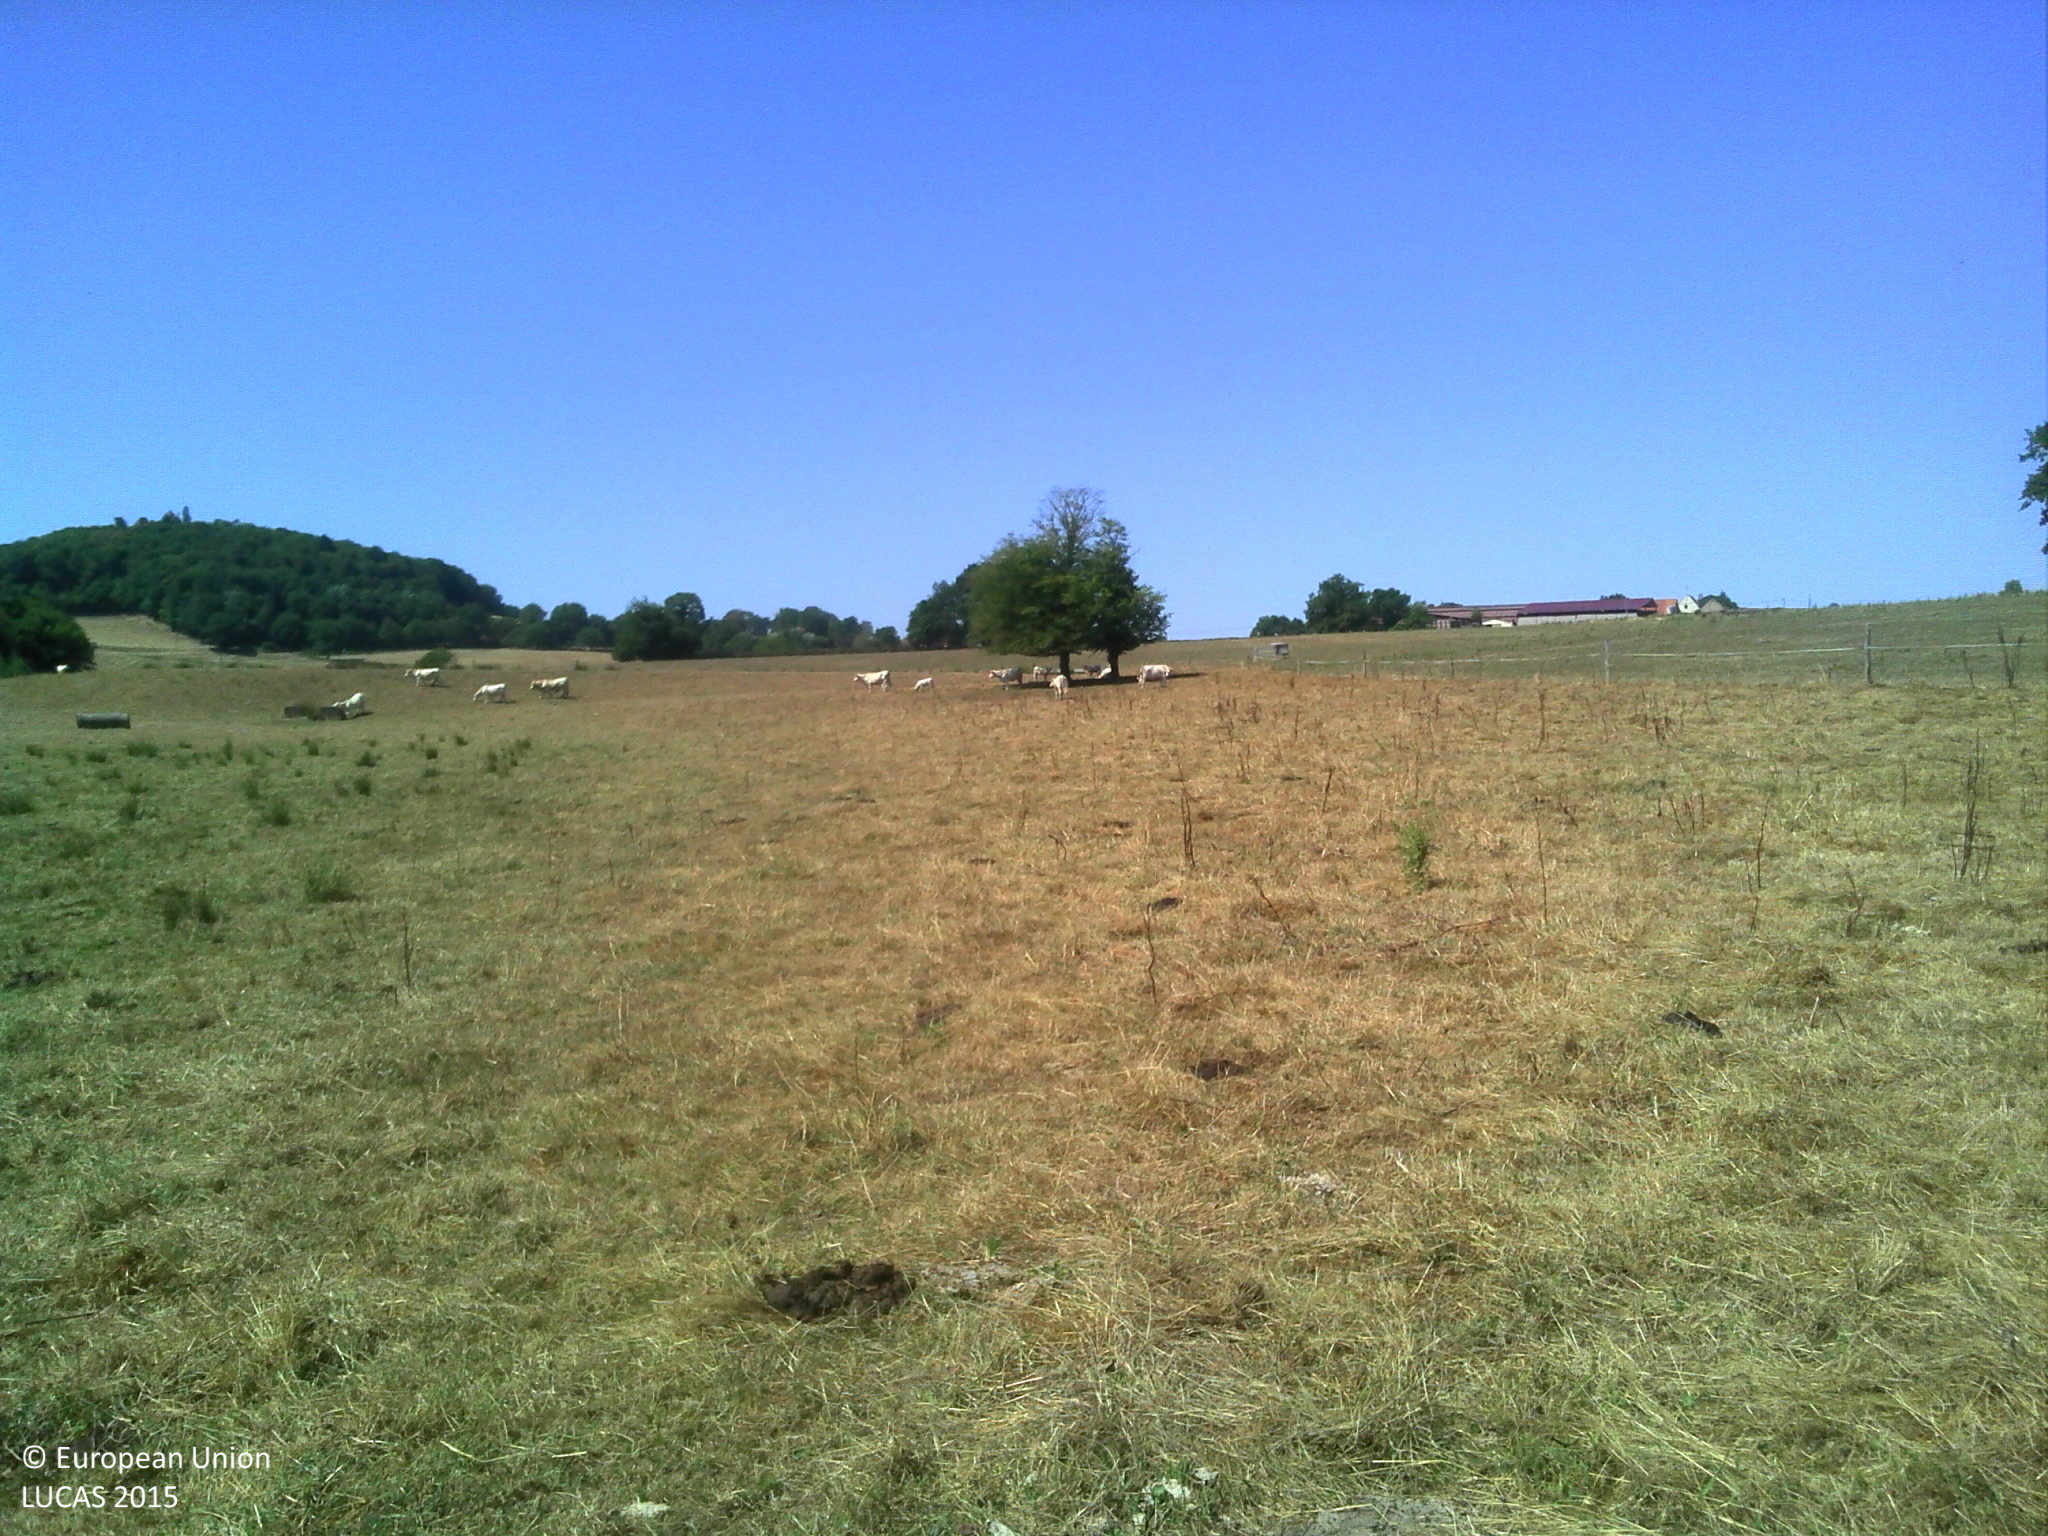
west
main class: Grassland
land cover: Grassland without tree/shrub cover
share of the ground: > 75 %
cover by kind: herbaceous plants 100 %
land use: Agriculture (excluding fallow land and kitchen gardens)
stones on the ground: 10 - 25 %
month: August
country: FR
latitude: 46.6775
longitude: 4.4710
